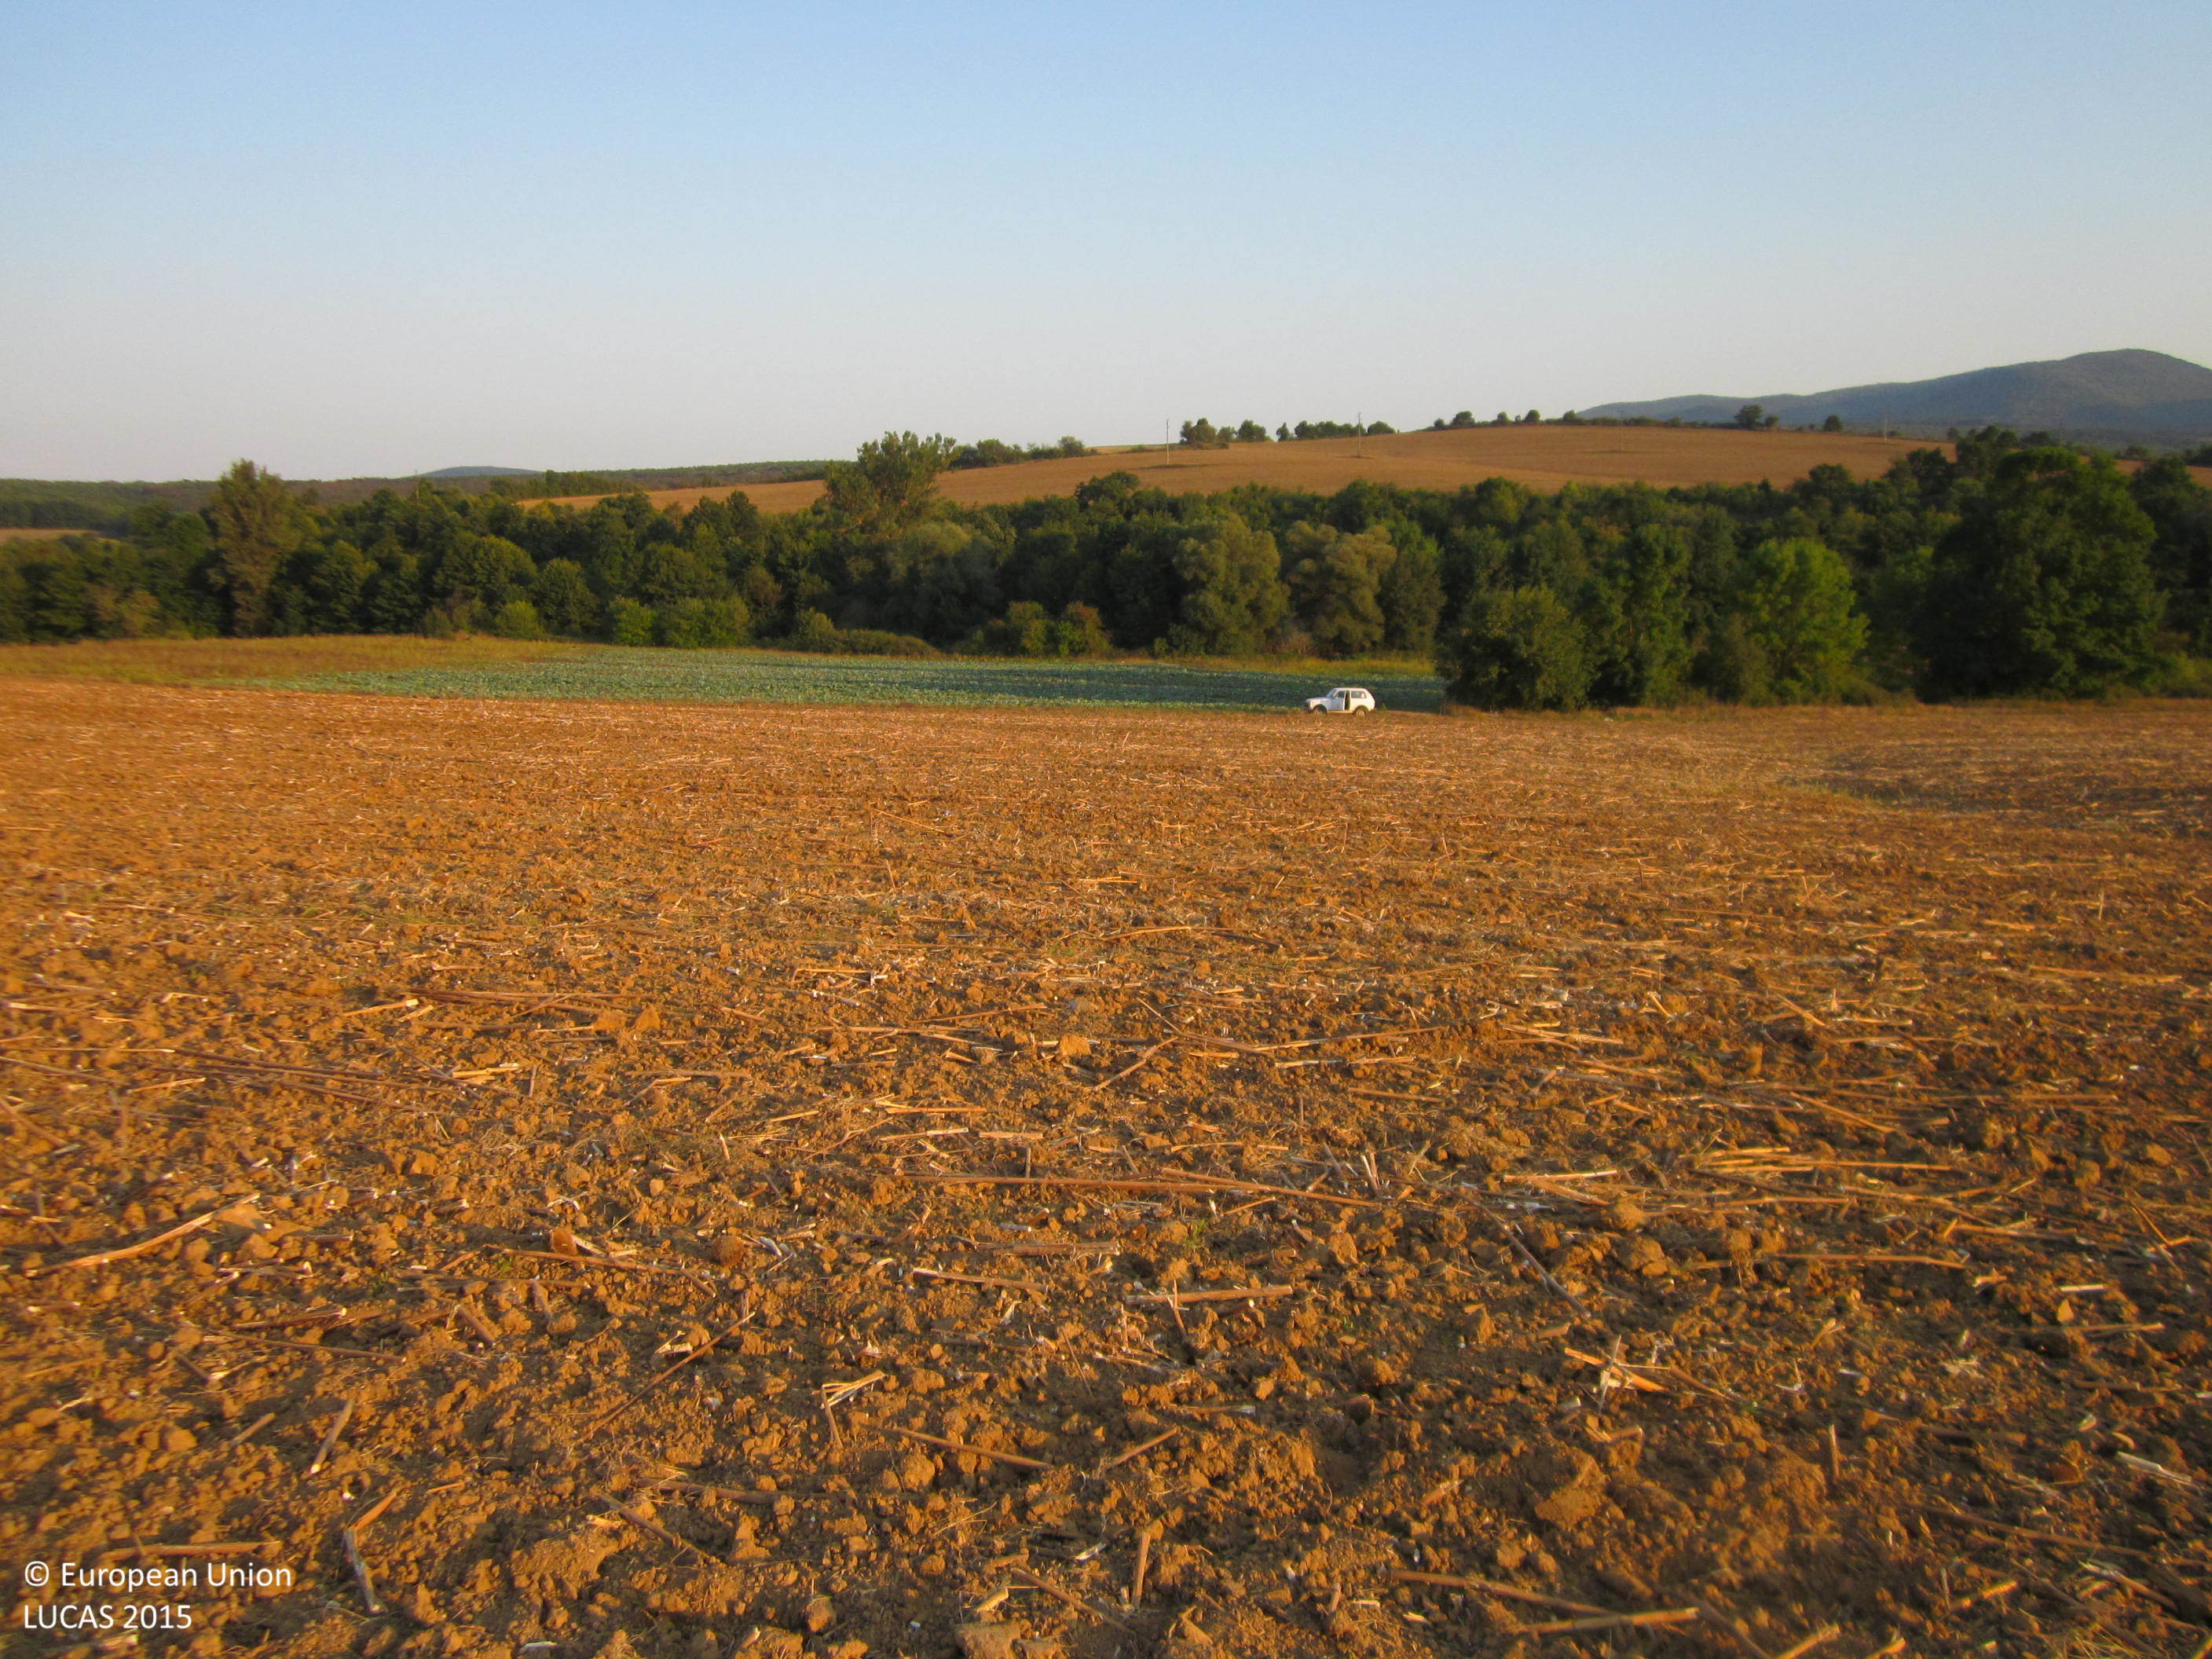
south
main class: Cropland
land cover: Sunflower
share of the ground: < 10 %
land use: Agriculture (excluding fallow land and kitchen gardens)
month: September
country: BG
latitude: 42.8258
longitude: 27.1022
